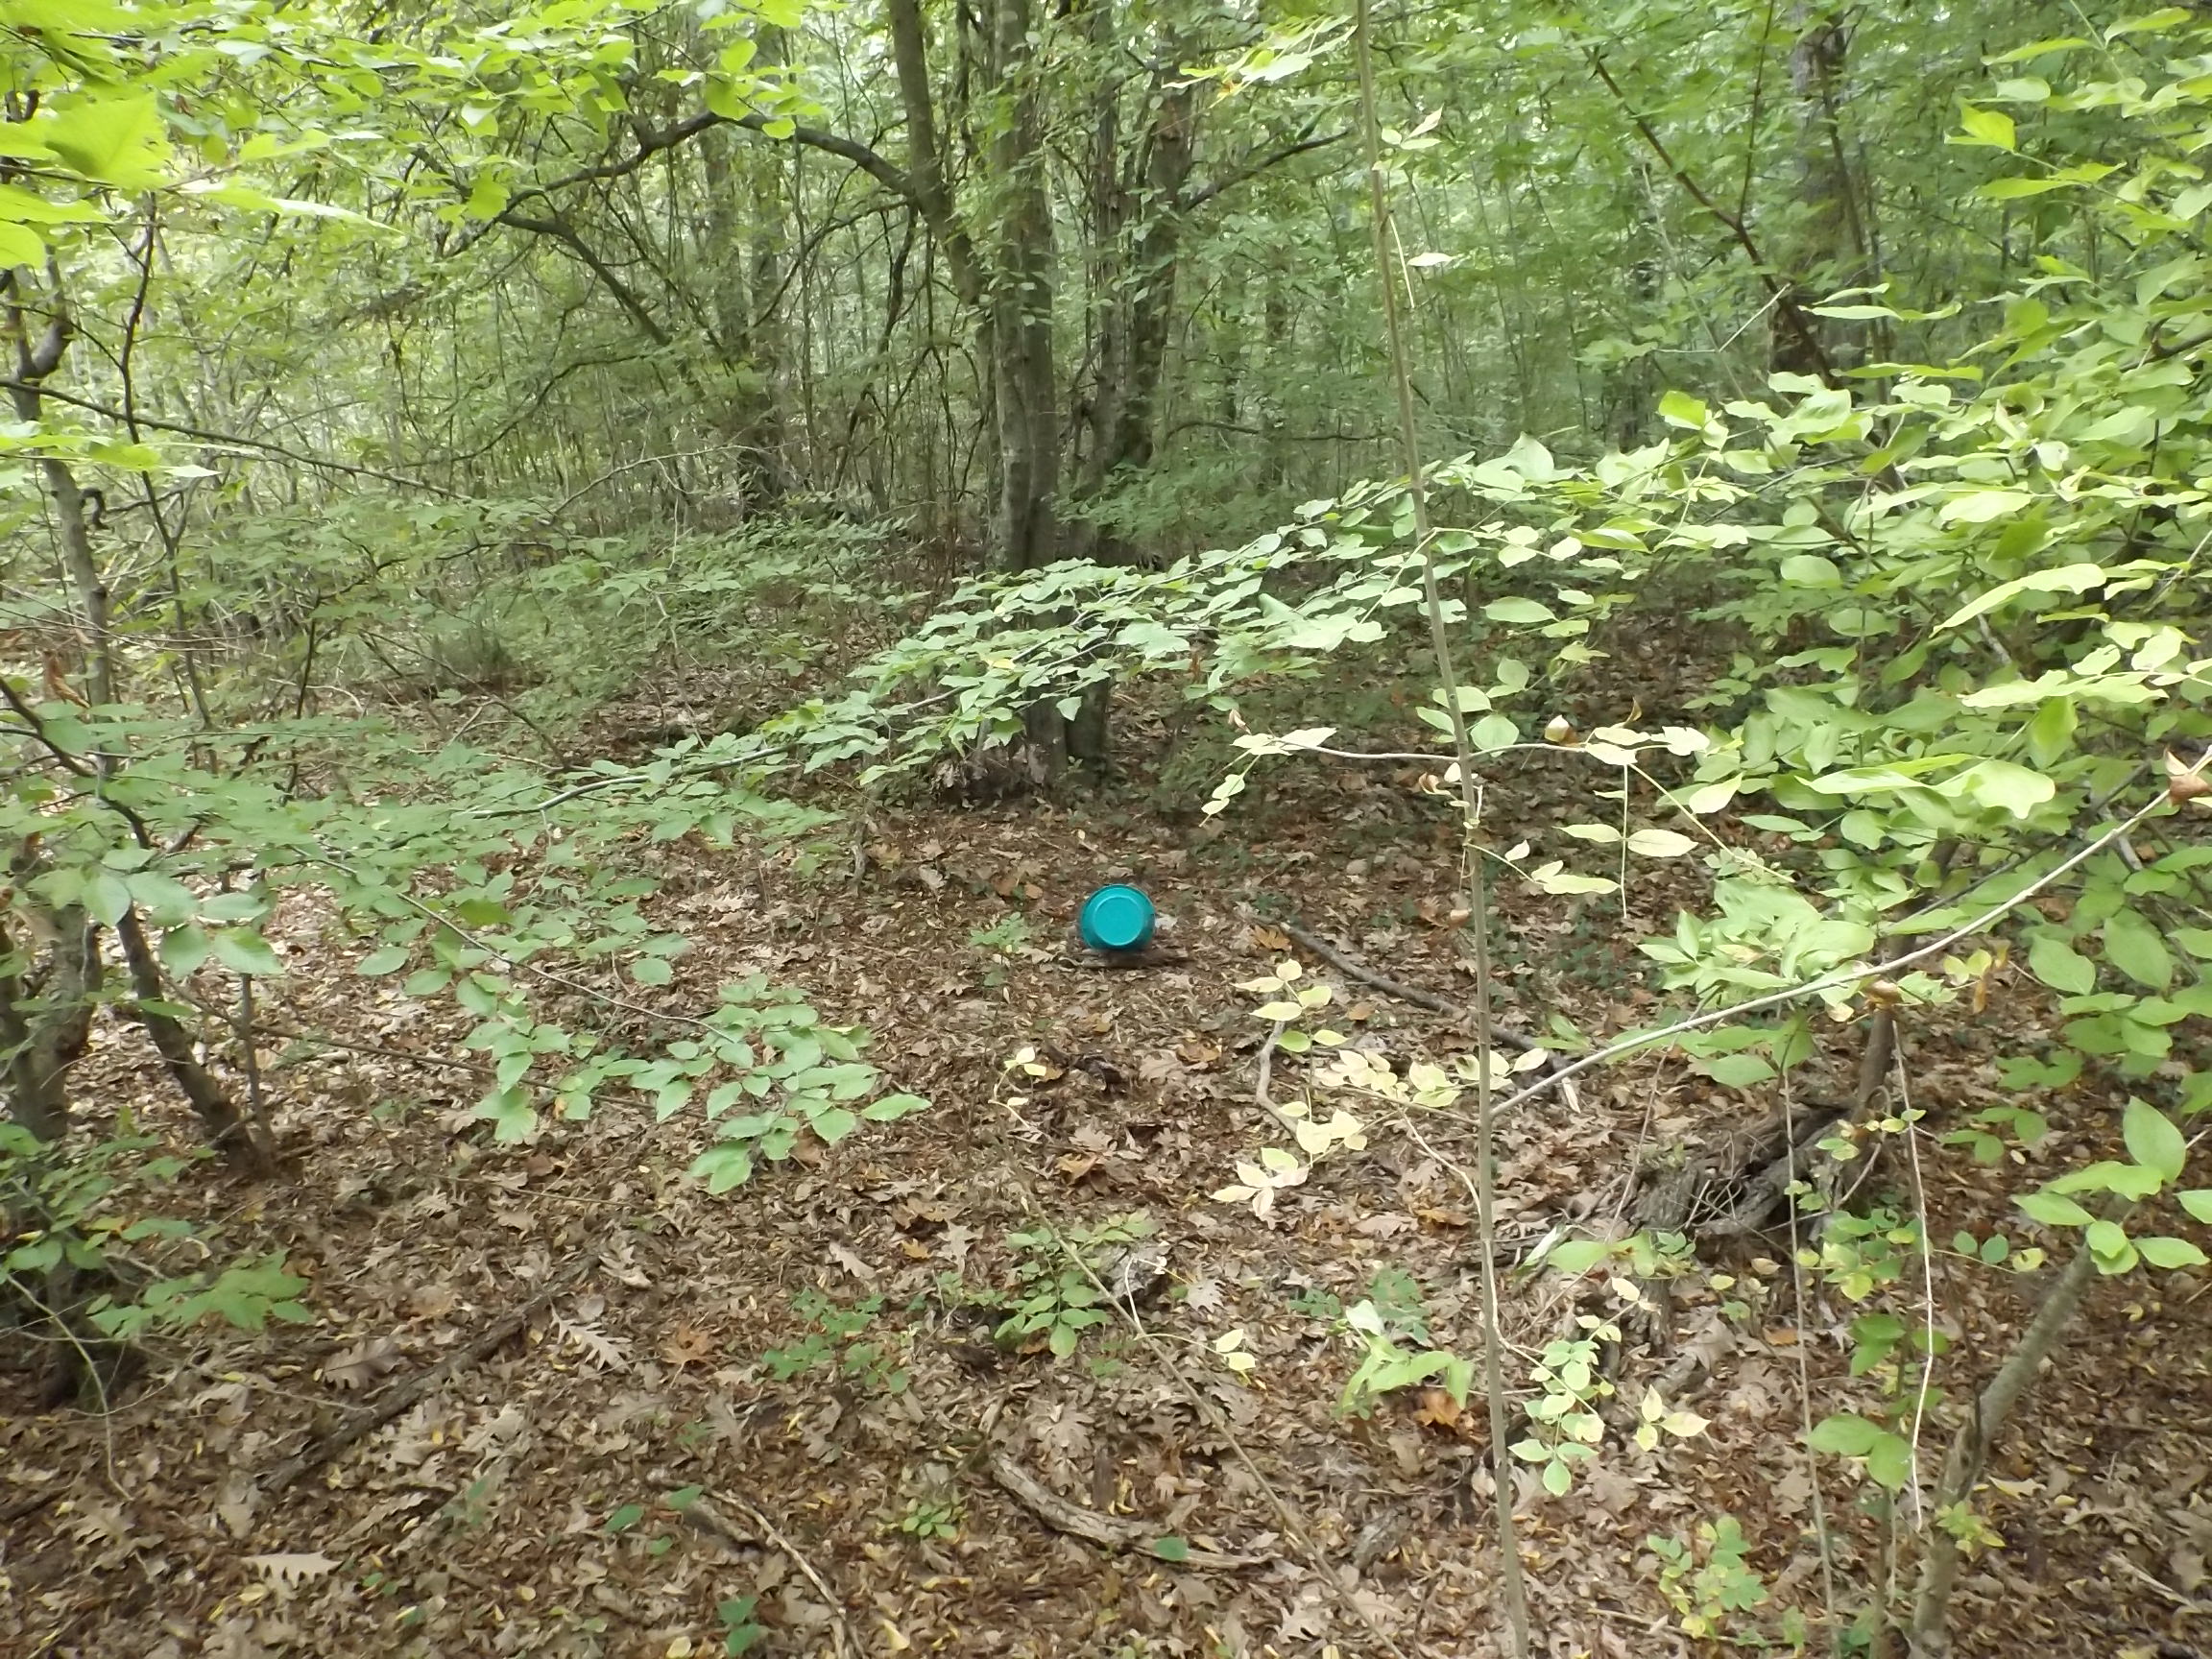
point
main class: Woodland
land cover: Broadleaved woodland
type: beech forest
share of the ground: > 75 %
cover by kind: broadleaved forest trees 100 %
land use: Forestry
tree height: > 5 m
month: October
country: BG
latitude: 42.9455
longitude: 27.8938
